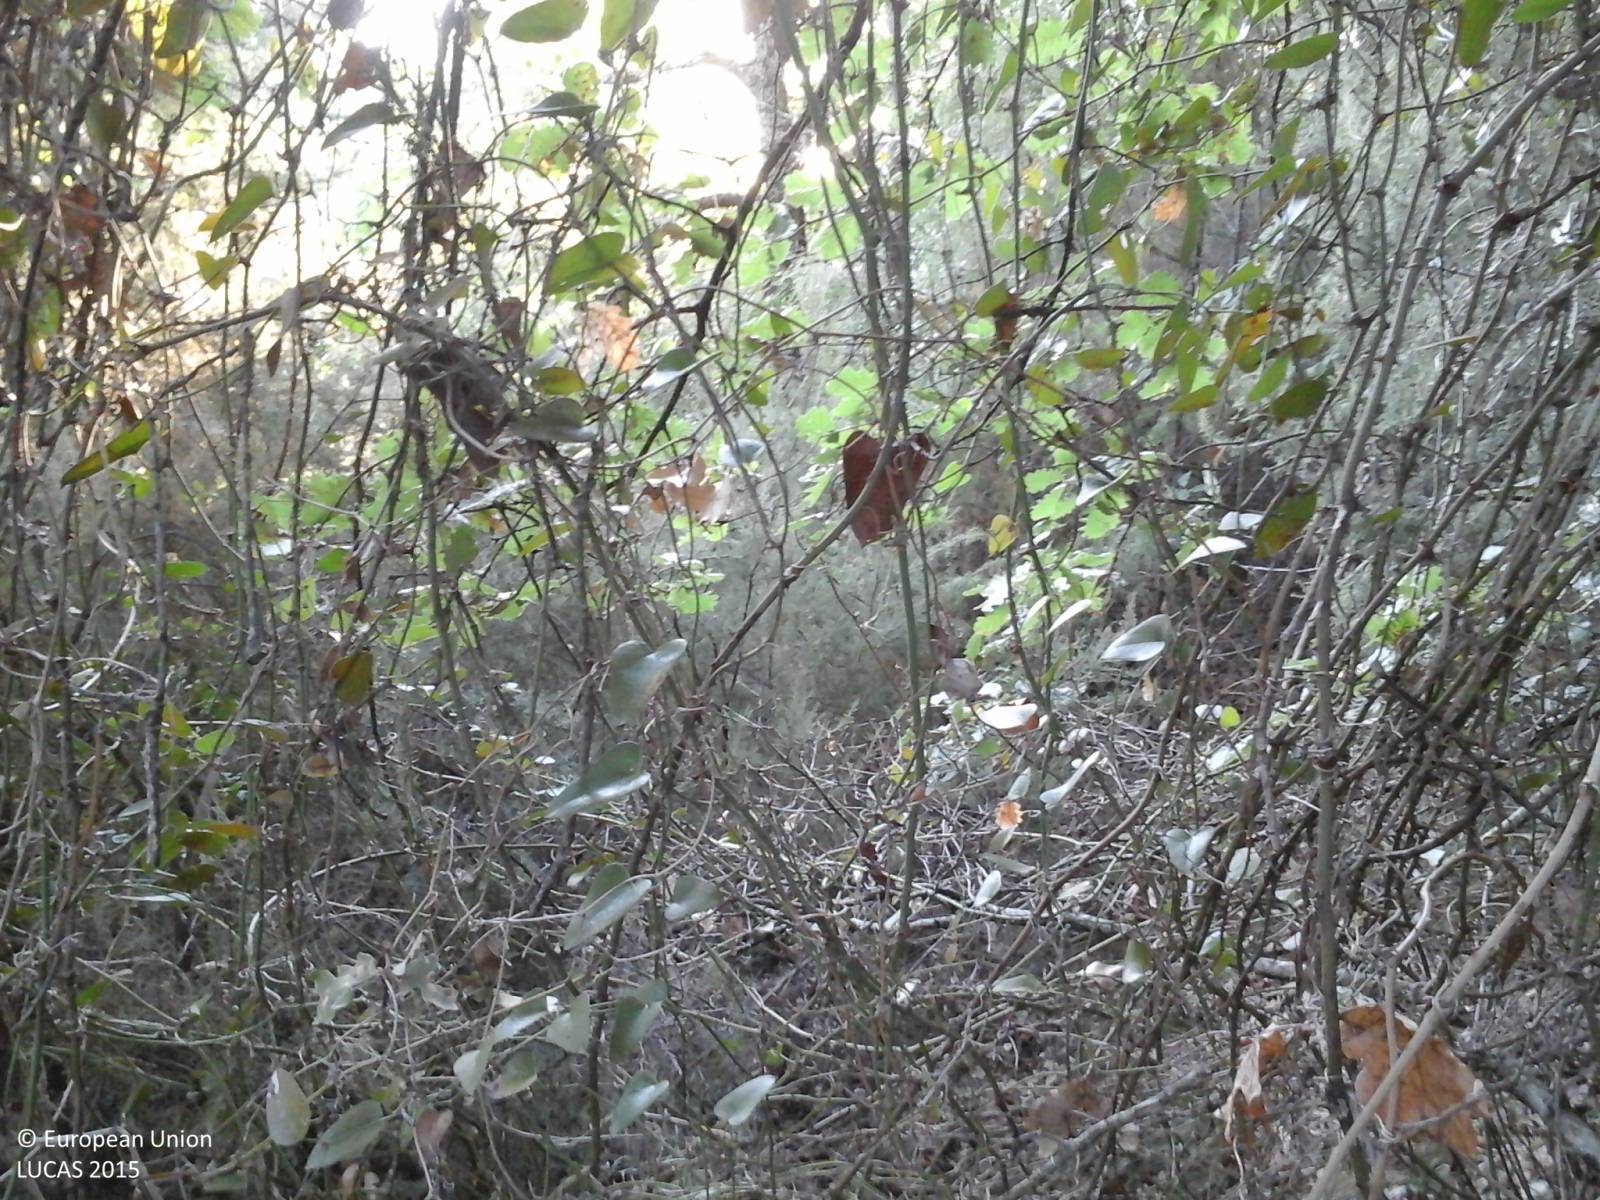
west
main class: Woodland
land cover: Broadleaved woodland
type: thermophilous deciduous forest
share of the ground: > 75 %
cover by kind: broadleaved forest trees 85 %, shrubs 15 %
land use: Forestry
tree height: > 5 m
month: September
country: IT
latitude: 42.8498
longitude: 12.0616
